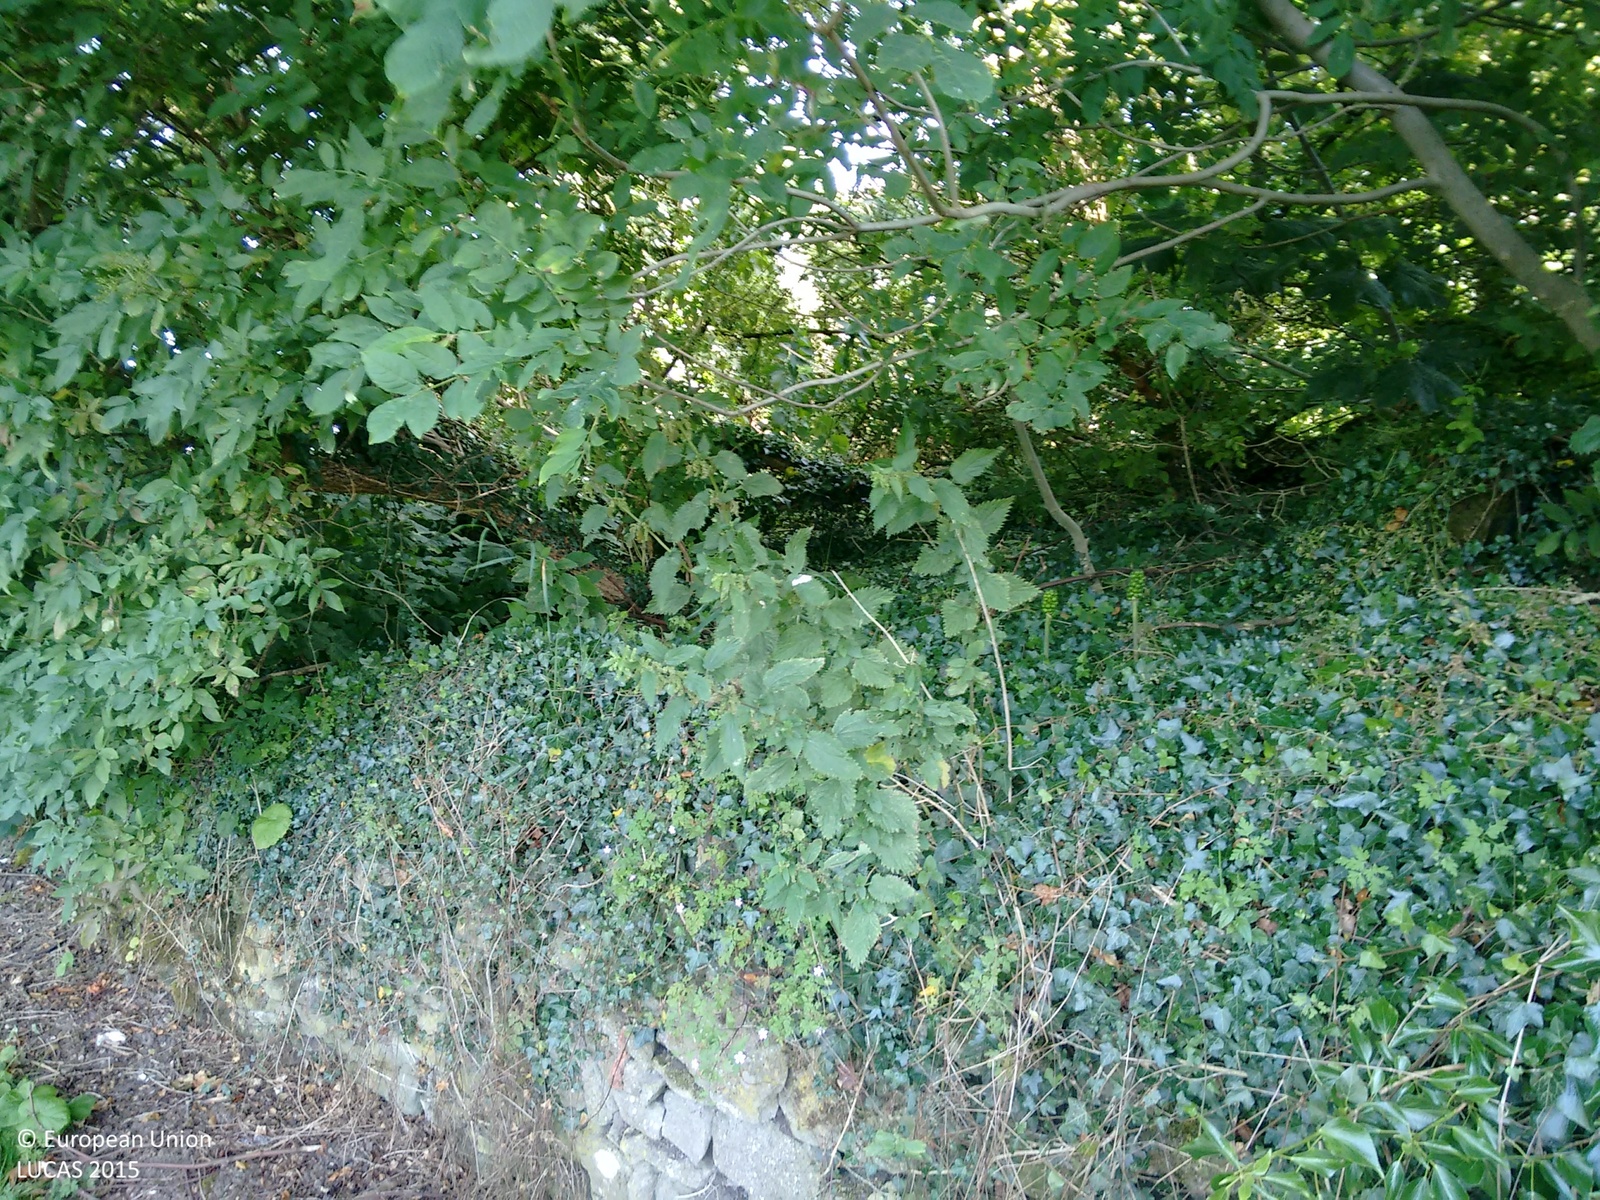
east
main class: Woodland
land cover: Broadleaved woodland
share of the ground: > 75 %
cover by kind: broadleaved forest trees 70 %, herbaceous plants 30 %
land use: Agriculture (excluding fallow land and kitchen gardens)
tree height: > 5 m
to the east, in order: Broadleaved woodland; Electric lines; Fences; Managed hedges; Grassland without tree/shrub cover; Fences; Managed hedges; Single bushes/trees; Grassland without tree/shrub cover
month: August
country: GB
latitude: 54.7468
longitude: -3.2662
